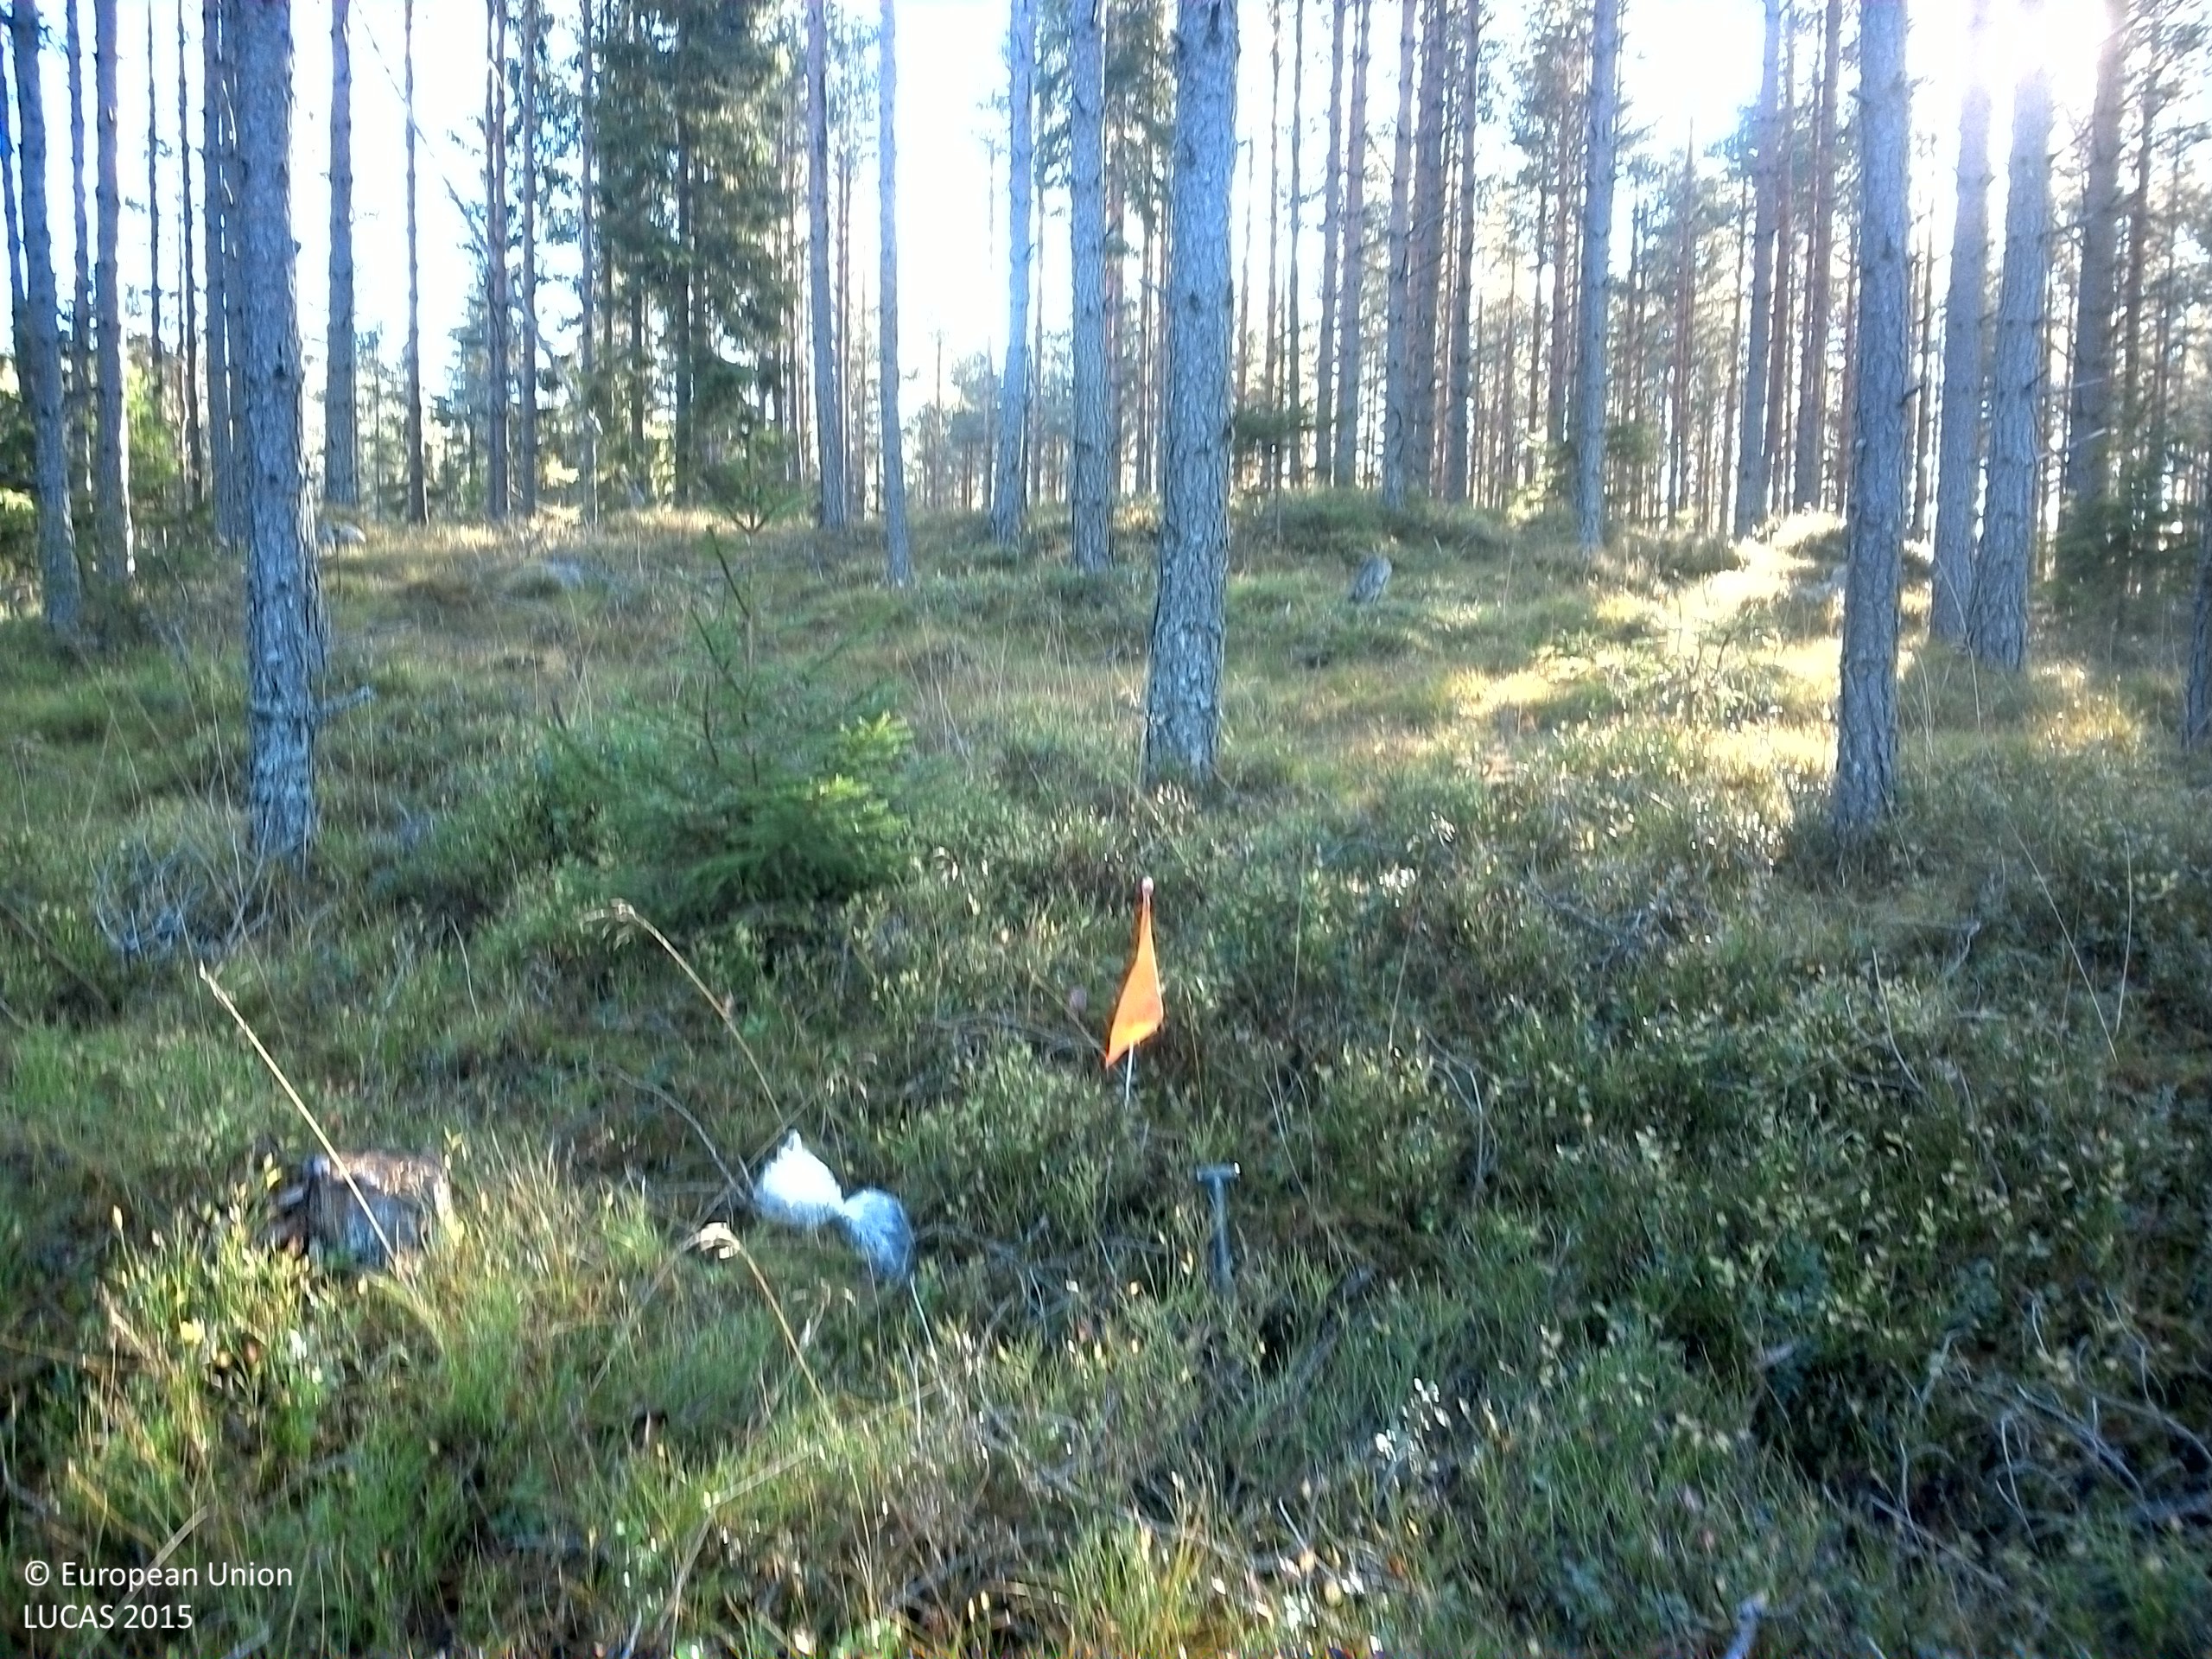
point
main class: Woodland
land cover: Pine dominated coniferous woodland
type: boreal forest
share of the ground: 50 - 75 %
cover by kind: coniferous forest trees 65 %, shrubs 20 %, lichens and mosses 10 %, herbaceous plants 5 %
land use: Forestry
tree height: > 5 m
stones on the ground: < 10 %
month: October
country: SE
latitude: 59.5764
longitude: 14.7886
